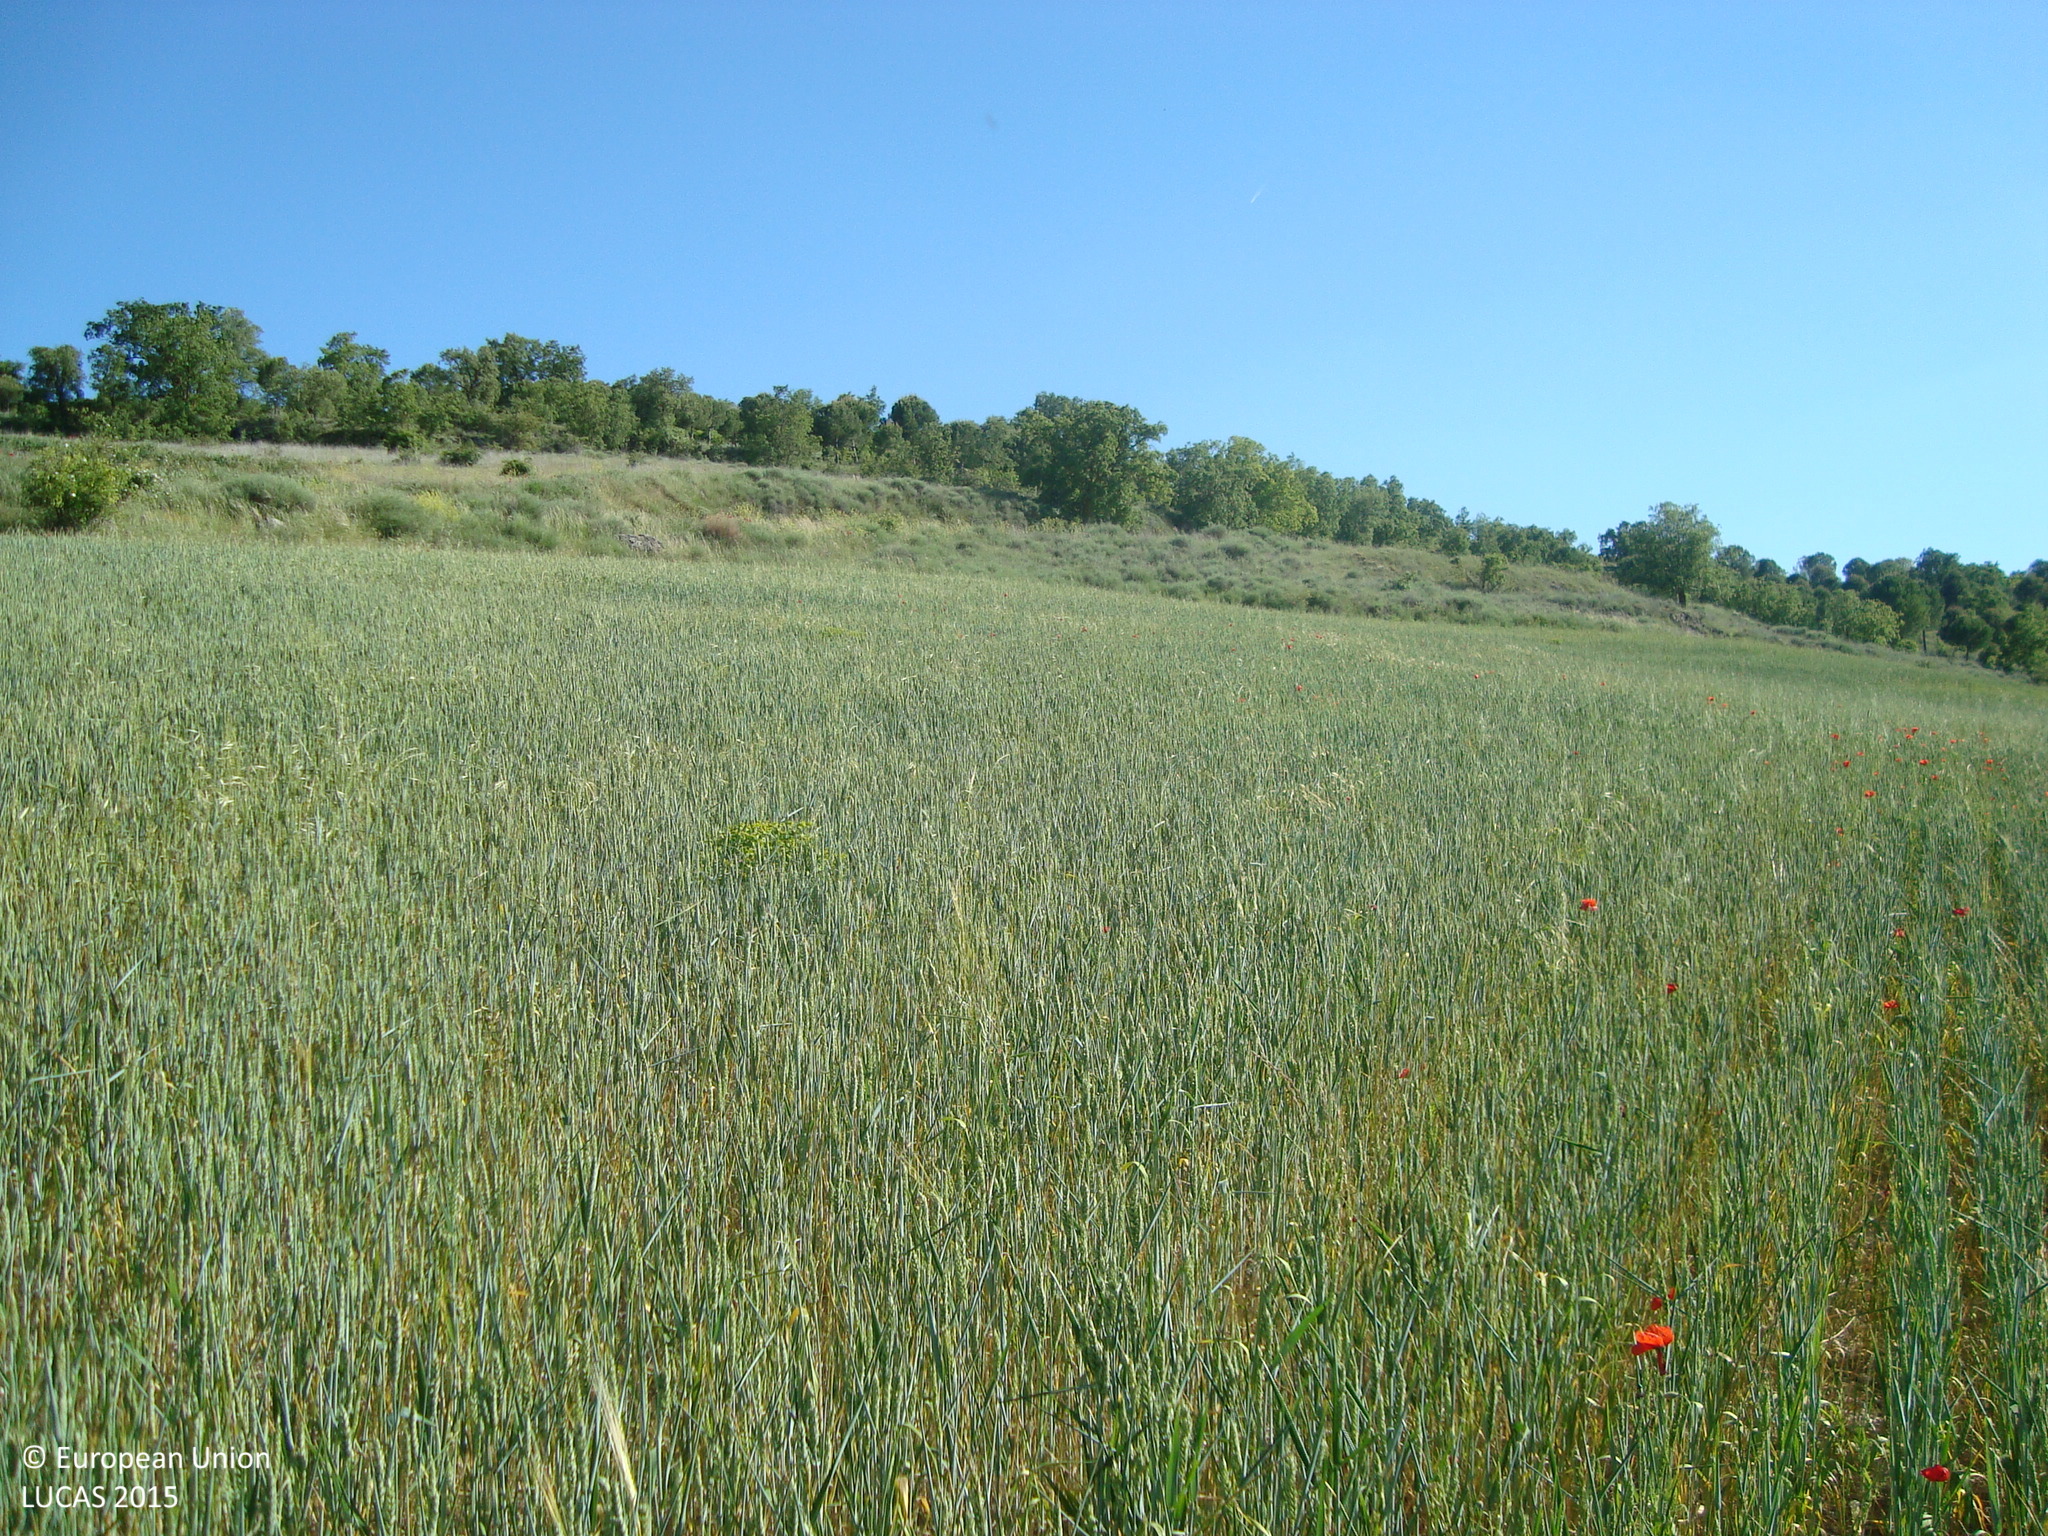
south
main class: Cropland
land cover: Common wheat
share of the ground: > 75 %
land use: Agriculture (excluding fallow land and kitchen gardens)
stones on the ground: < 10 %
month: May
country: ES
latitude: 41.5206
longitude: -4.0651
